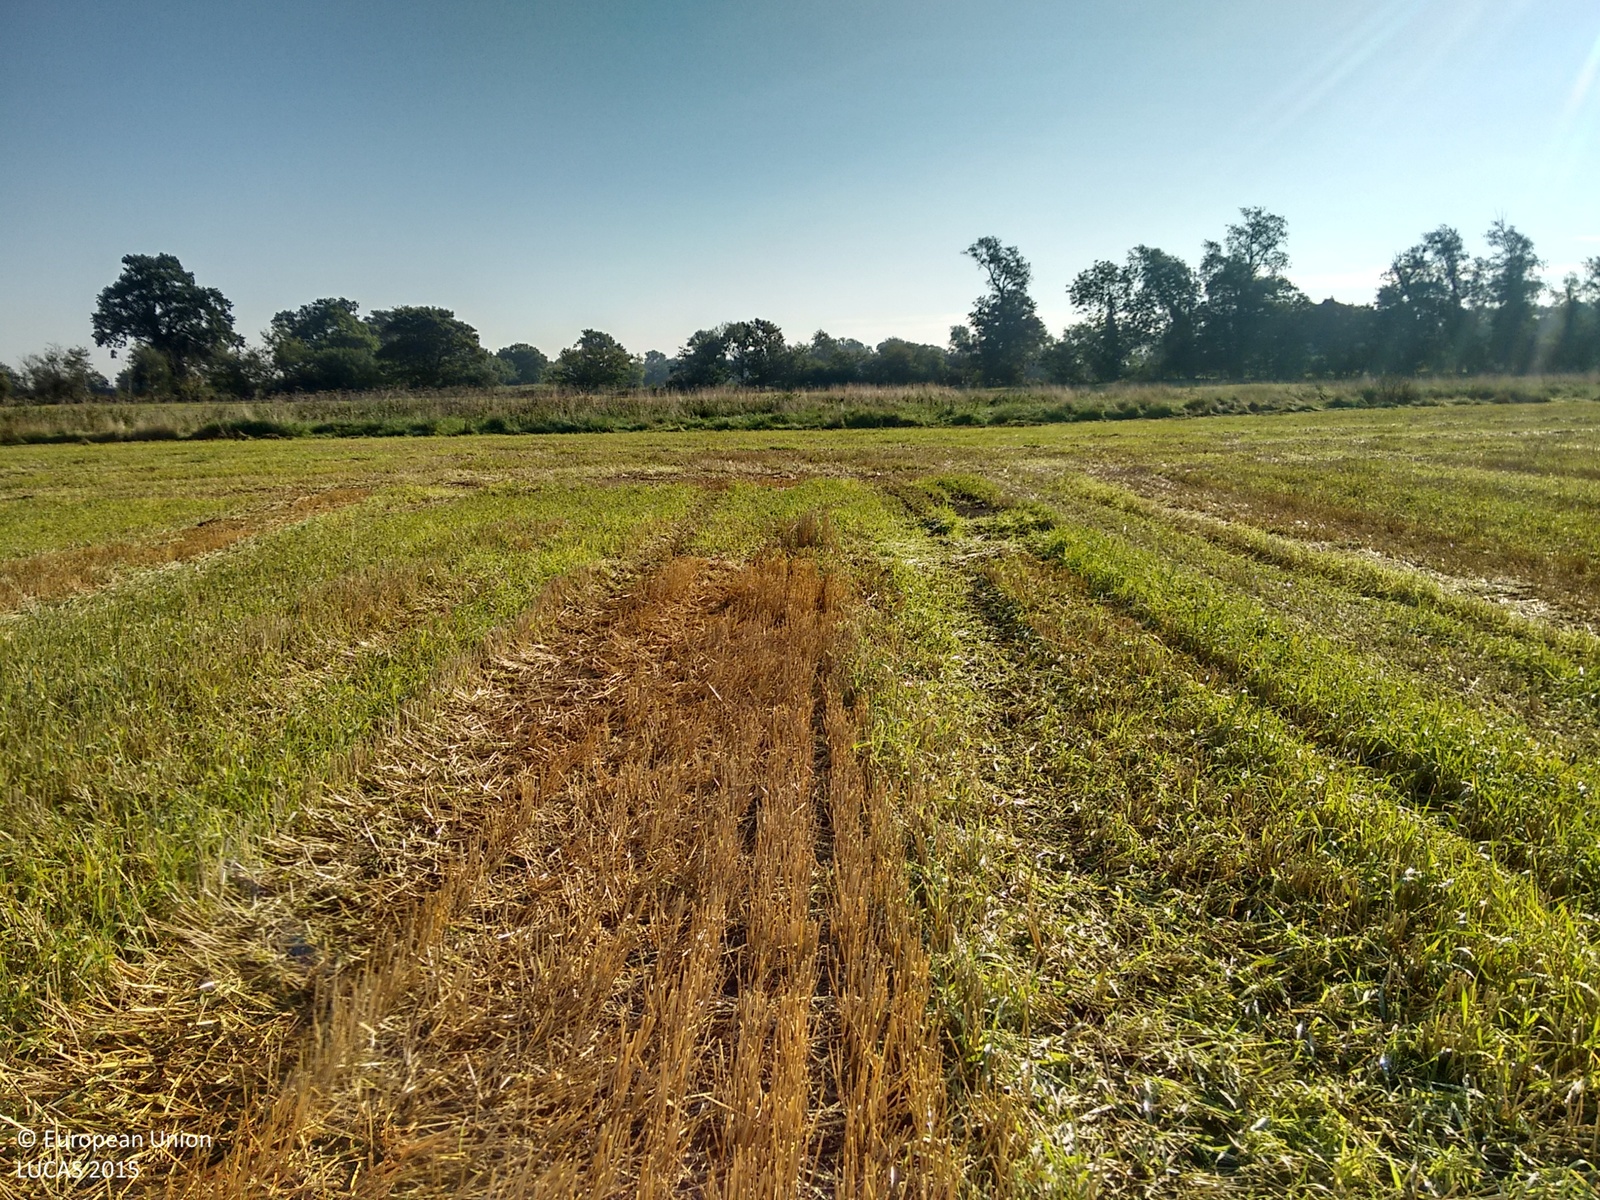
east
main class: Cropland
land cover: Barley
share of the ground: > 75 %
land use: Agriculture (excluding fallow land and kitchen gardens)
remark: Harvested field
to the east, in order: Barley; Grassland without tree/shrub cover; Ditches and canals; Grassland without tree/shrub cover; Barley; Grass margins; Lines of trees; Ditches and canals; Grass margins; Barley
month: September
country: GB
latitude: 52.2251
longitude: 0.2049
